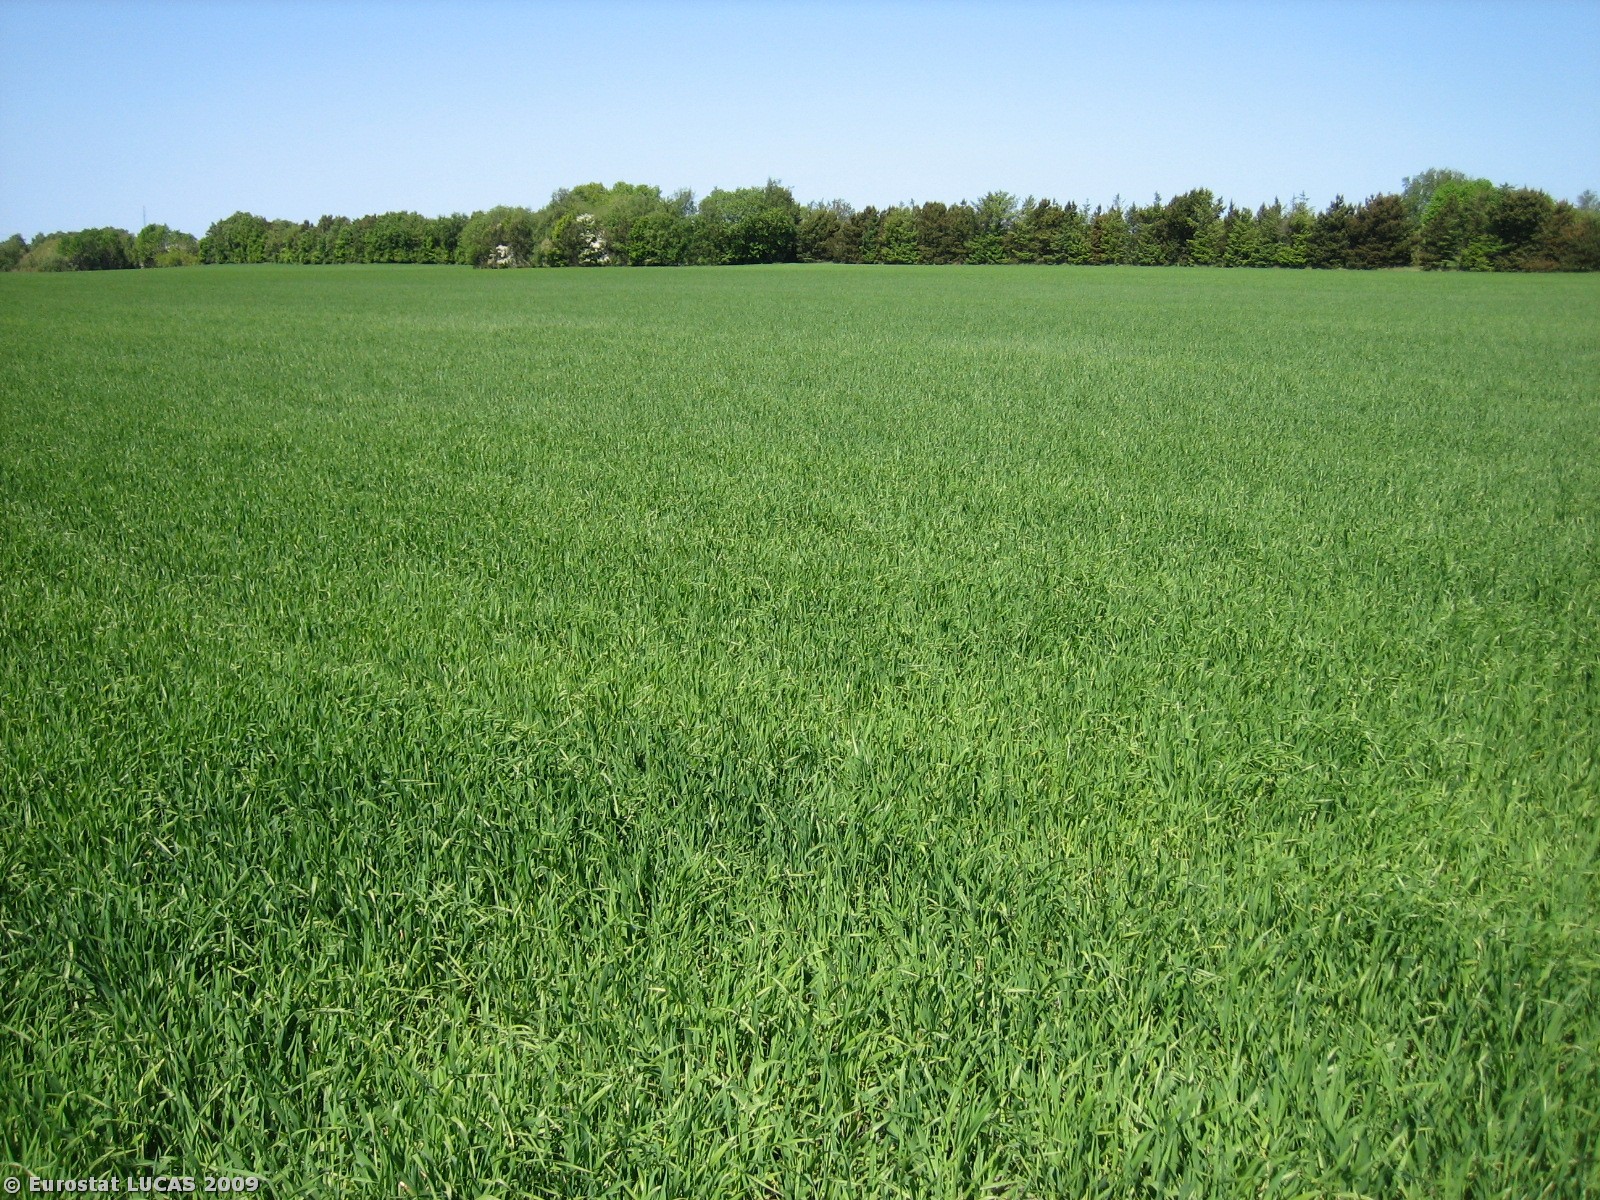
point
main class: Cropland
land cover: Barley
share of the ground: > 75 %
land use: Agriculture (excluding fallow land and kitchen gardens)
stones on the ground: < 10 %
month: May
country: DK
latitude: 55.9305
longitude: 8.8008
